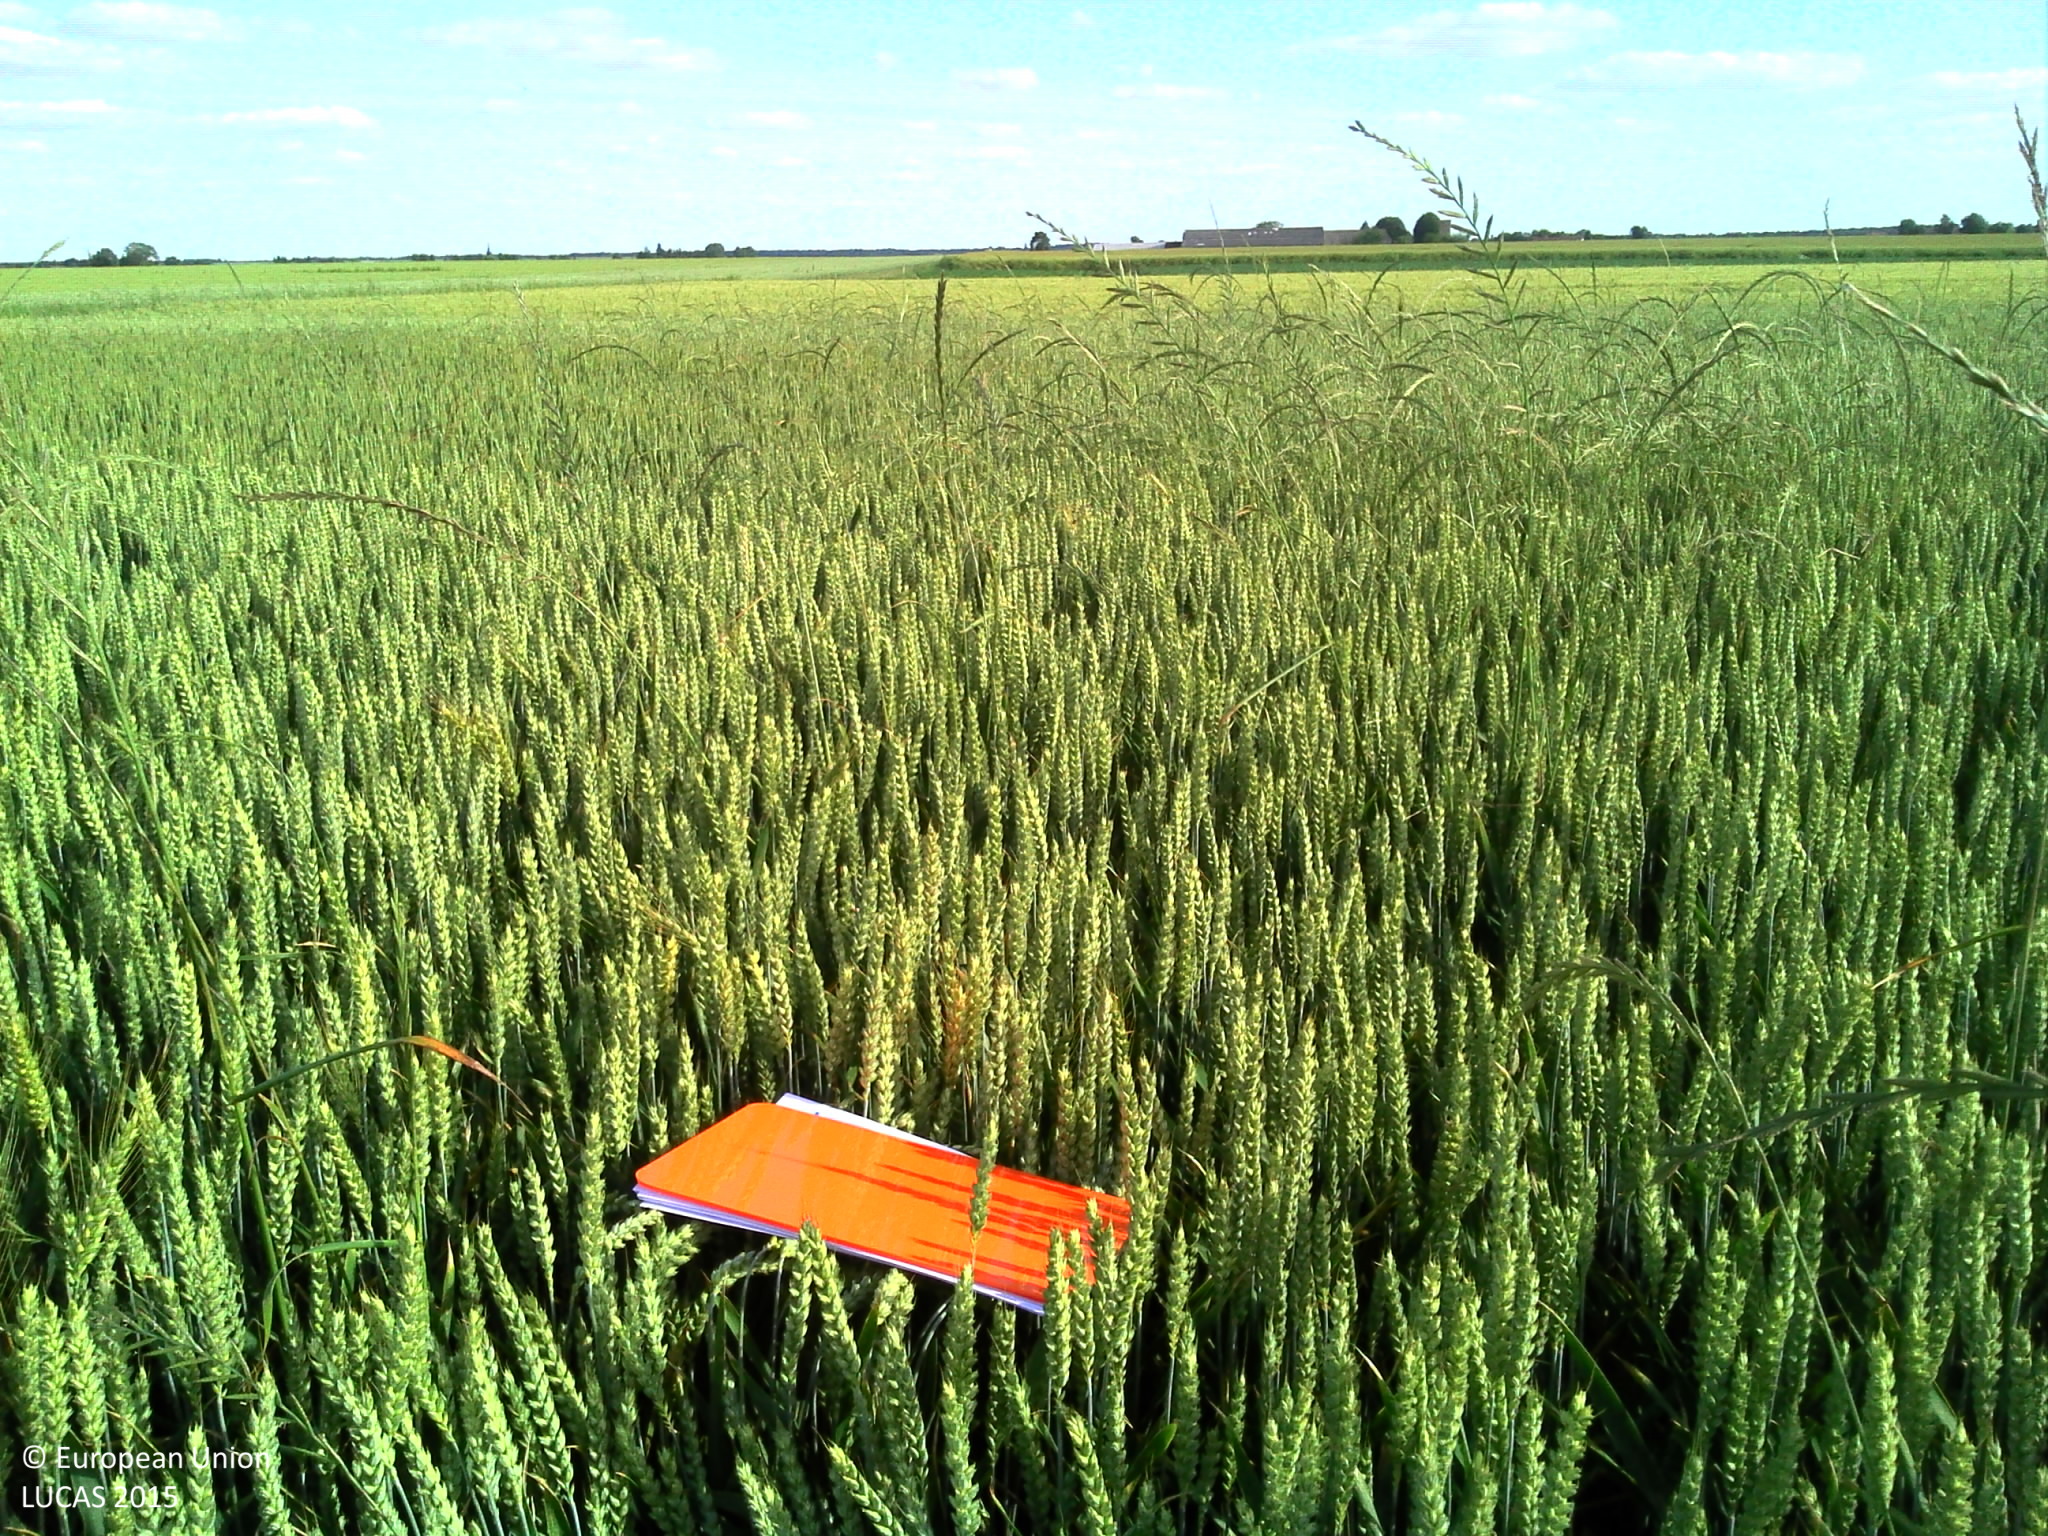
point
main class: Cropland
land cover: Common wheat
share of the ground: > 75 %
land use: Agriculture (excluding fallow land and kitchen gardens)
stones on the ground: < 10 %
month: June
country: FR
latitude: 49.2001
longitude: 1.0718
